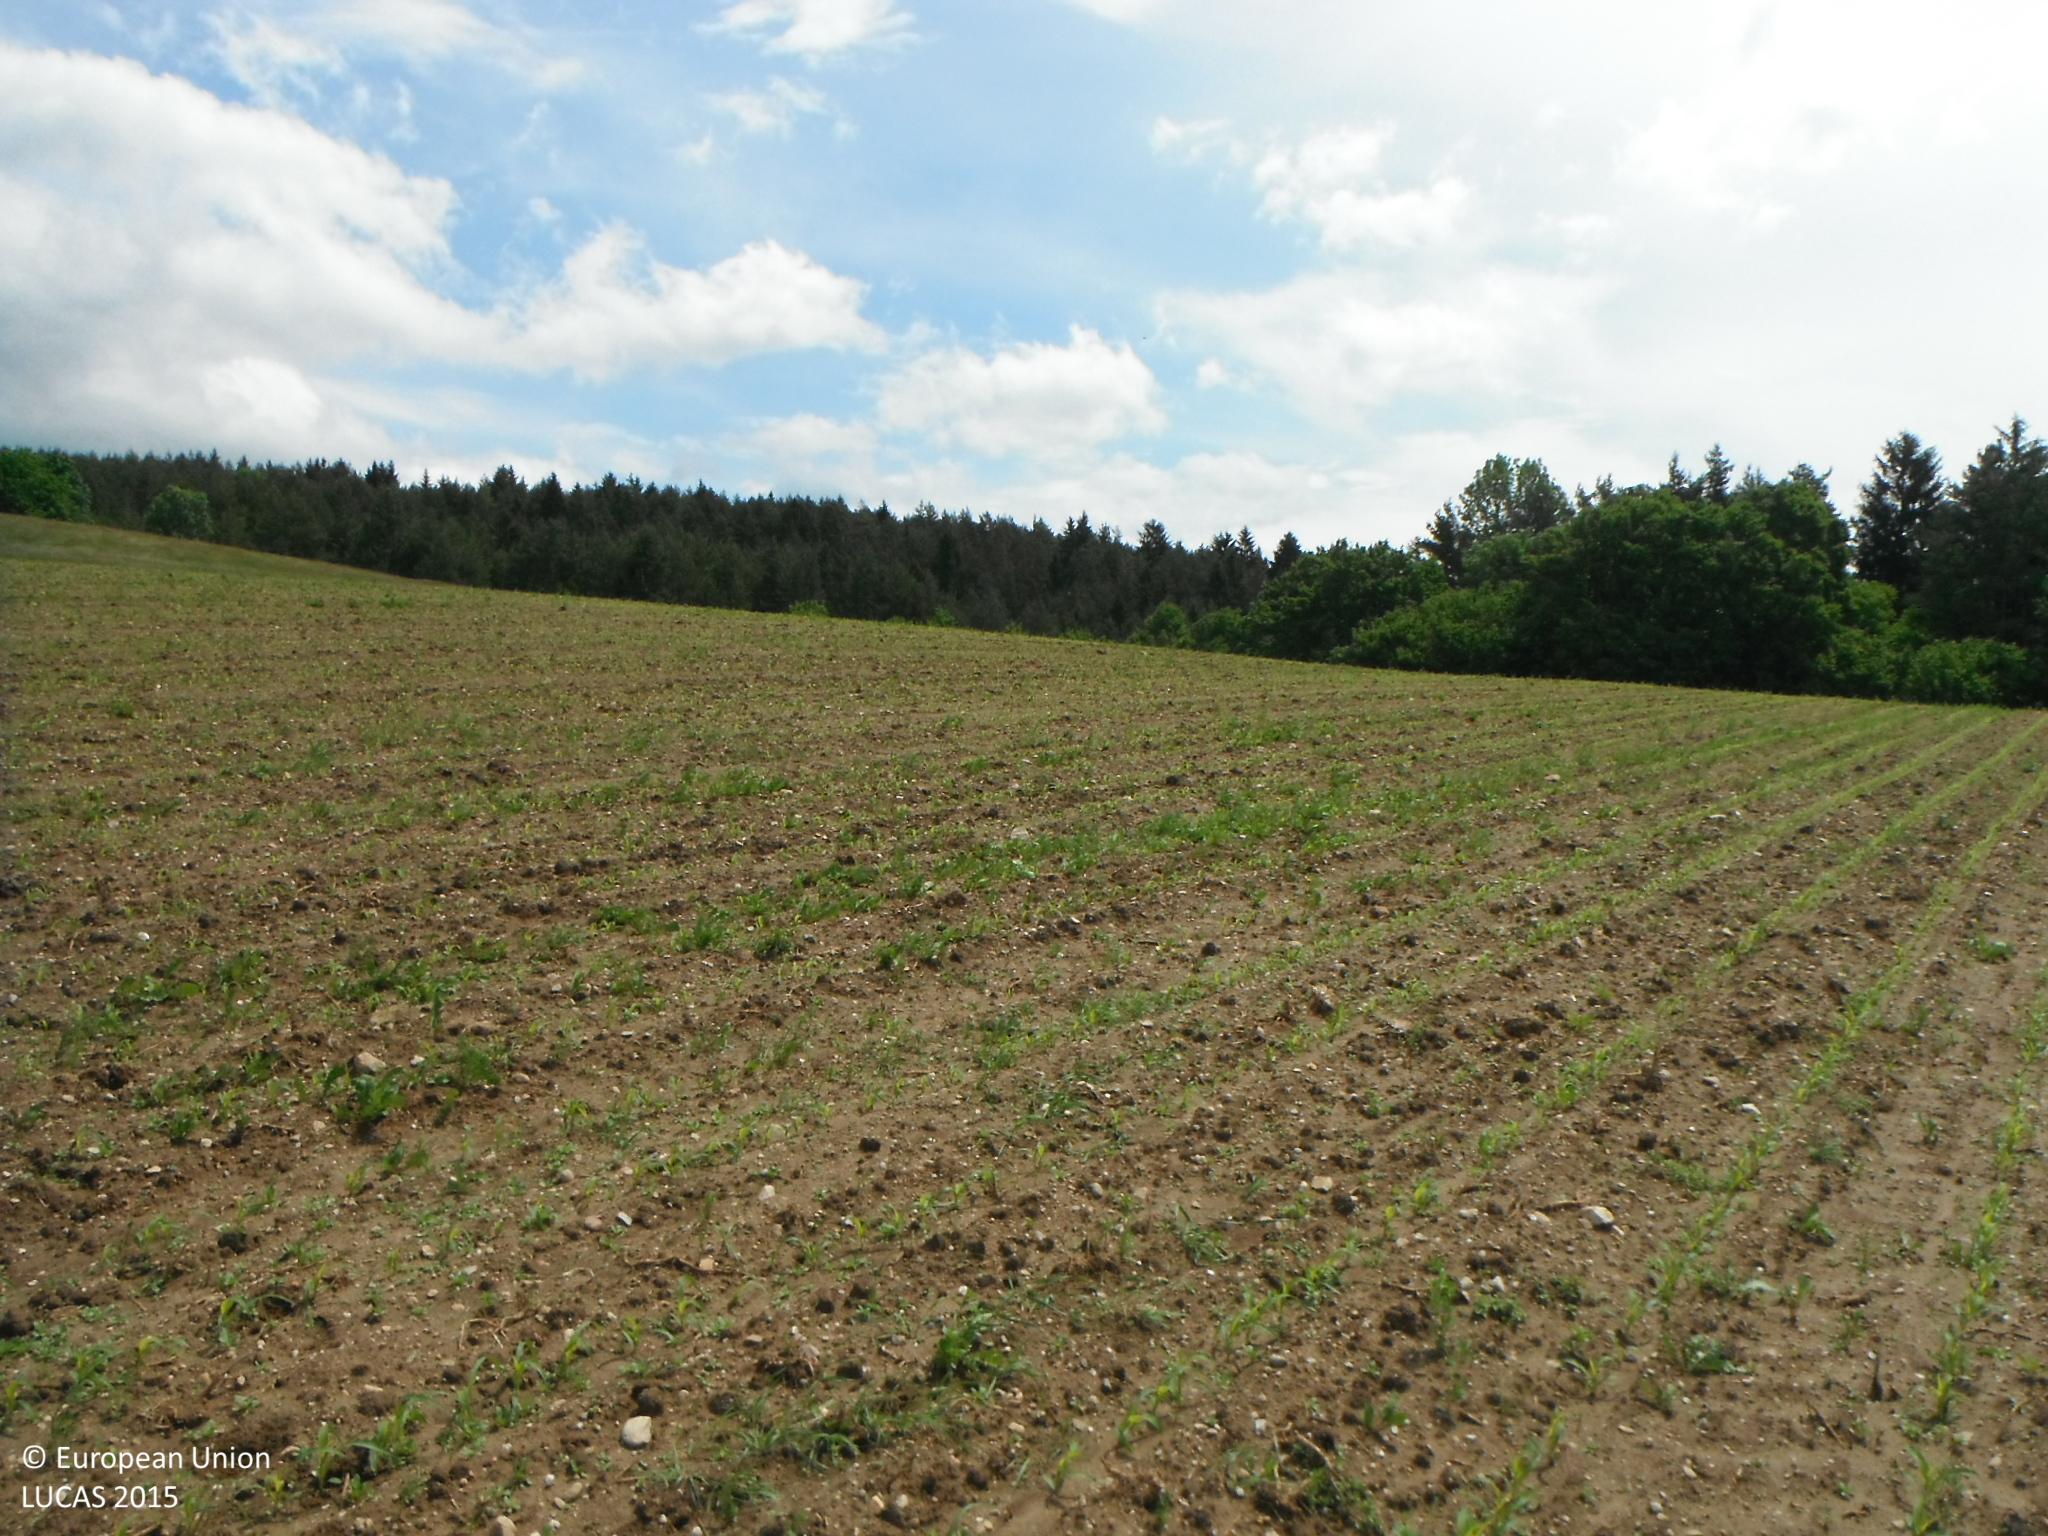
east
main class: Artificial land
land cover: Other artificial areas
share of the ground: > 75 %
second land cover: Maize
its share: < 10 %
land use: Electricity, gas and thermal power distribution
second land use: Agriculture (excluding fallow land and kitchen gardens)
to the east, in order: Artificial constructions in urban areas; Maize; Shrubland without tree cover; Broadleaved woodland; Pine dominated mixed woodland
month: May
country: SK
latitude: 48.7923
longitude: 19.2661
